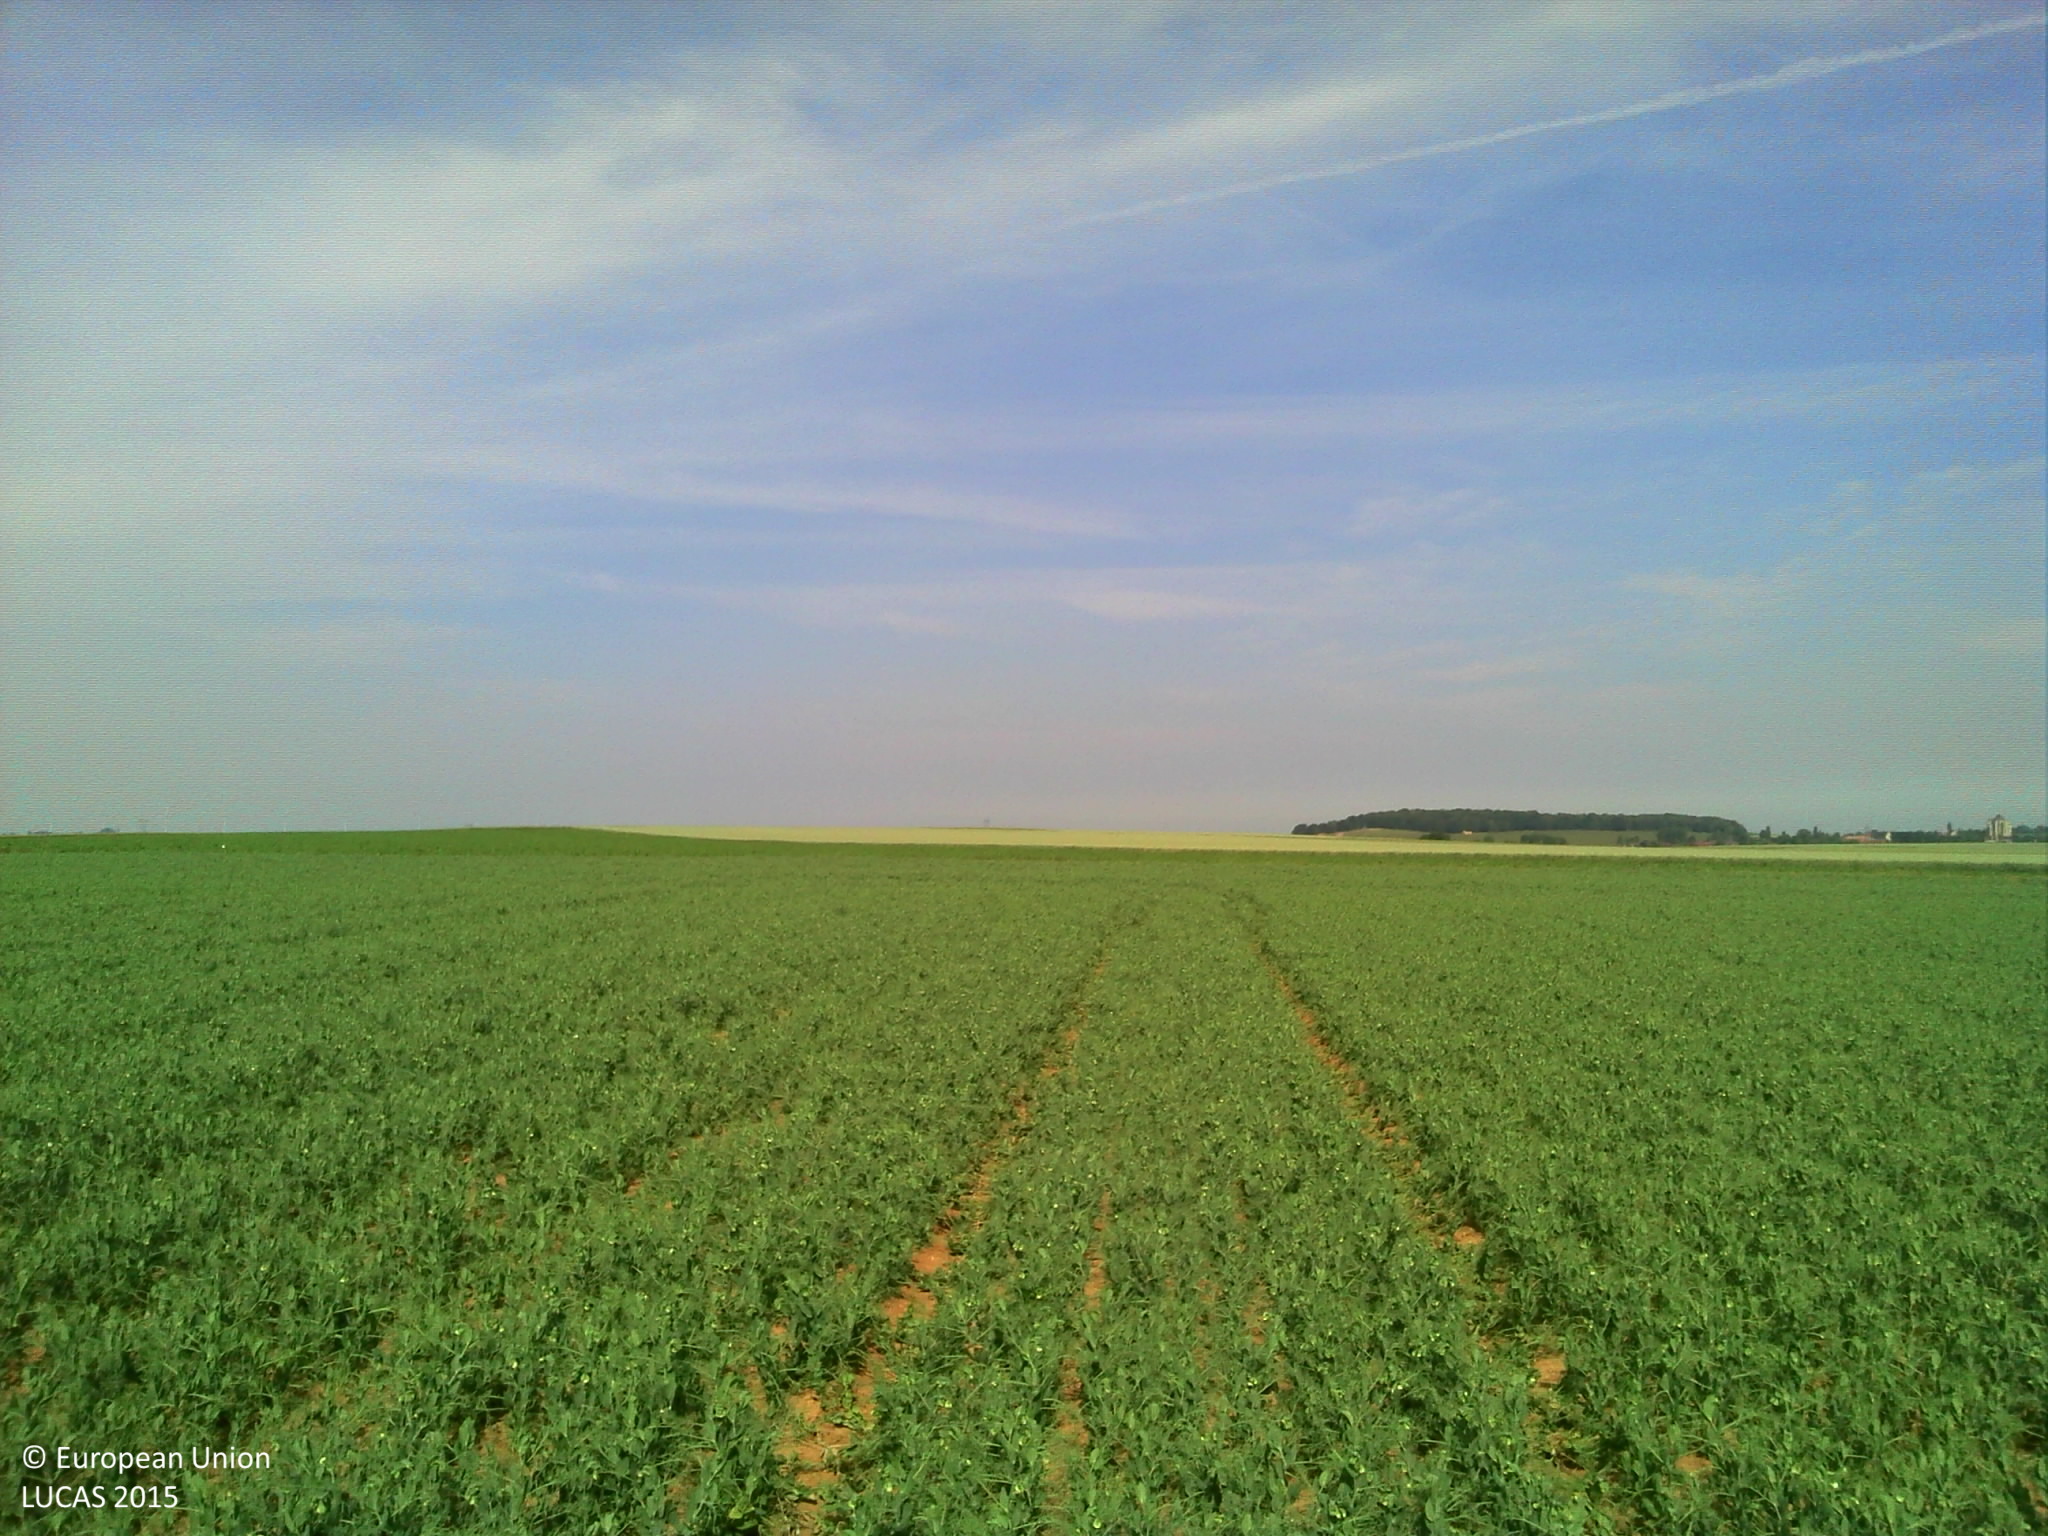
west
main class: Cropland
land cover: Dry pulses
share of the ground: > 75 %
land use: Agriculture (excluding fallow land and kitchen gardens)
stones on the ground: < 10 %
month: June
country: FR
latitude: 49.5102
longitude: 2.5997
